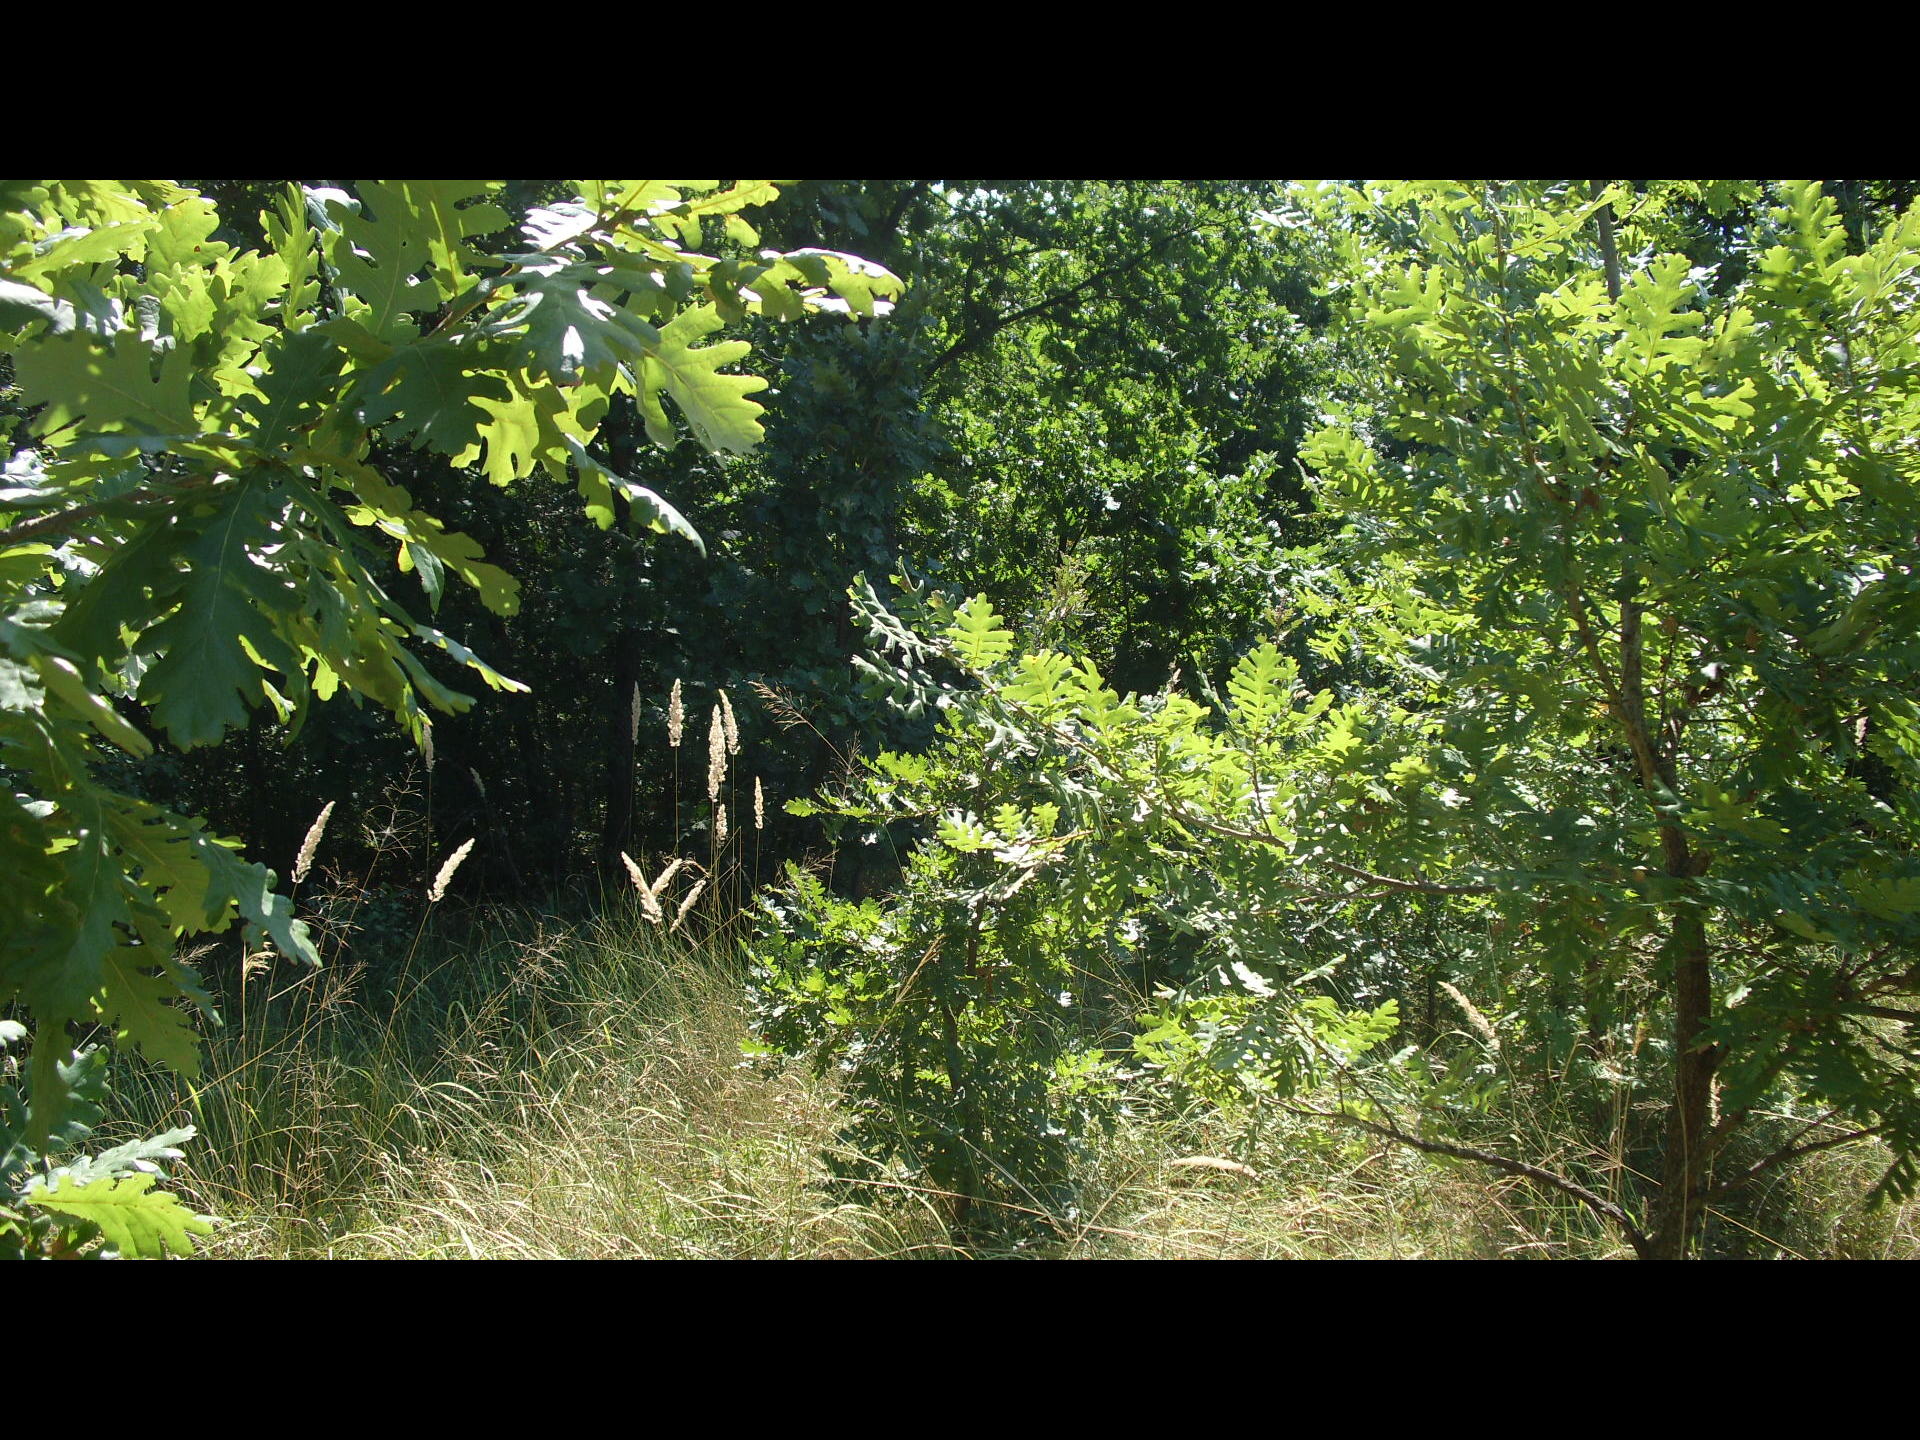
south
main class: Woodland
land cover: Broadleaved woodland
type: mesophytic deciduous forest
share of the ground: 50 - 75 %
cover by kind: broadleaved forest trees 60 %, herbaceous plants 30 %, shrubs 10 %
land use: Forestry
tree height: > 5 m
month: August
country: BG
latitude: 43.5205
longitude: 23.0657
